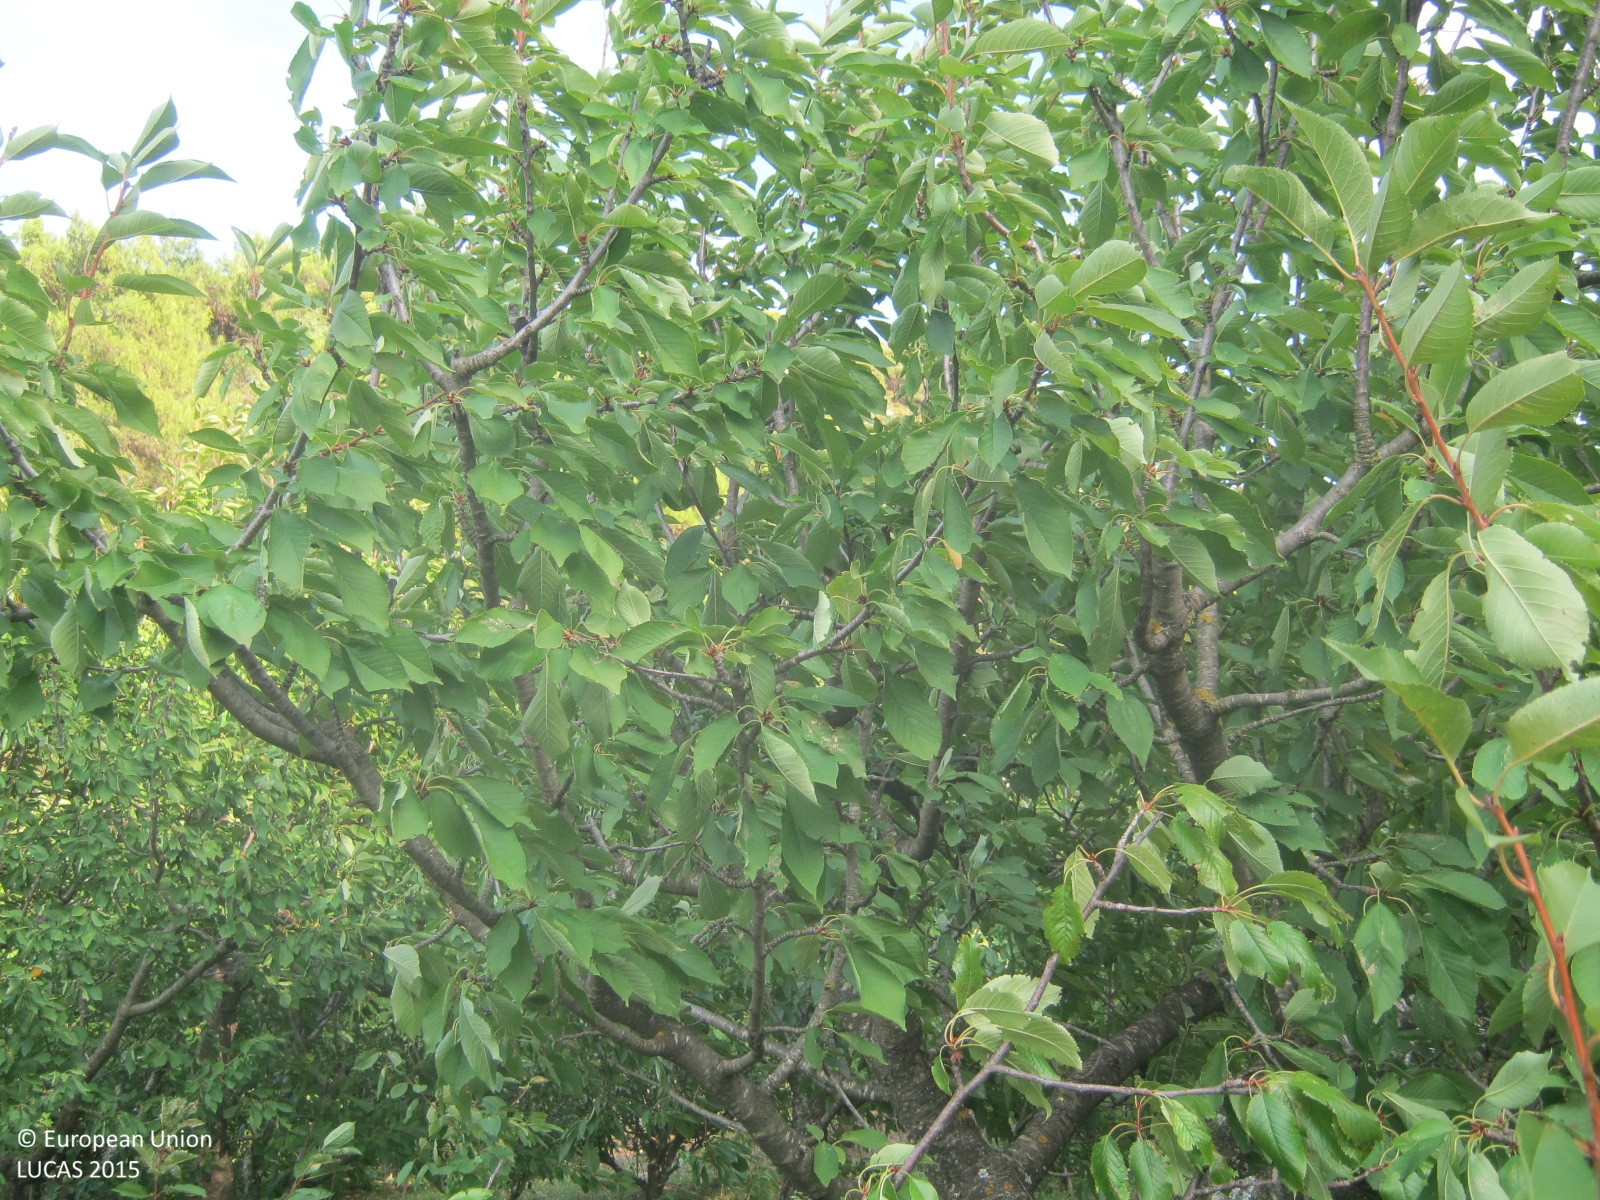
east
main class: Cropland
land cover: Cherry fruit
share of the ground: 50 - 75 %
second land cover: Spontaneously vegetated surfaces
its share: > 75 %
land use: Agriculture (excluding fallow land and kitchen gardens)
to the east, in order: Cherry fruit; Spontaneously vegetated surfaces; Broadleaved woodland; Pine dominated mixed woodland
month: September
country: GR
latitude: 38.2703
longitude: 21.8213
